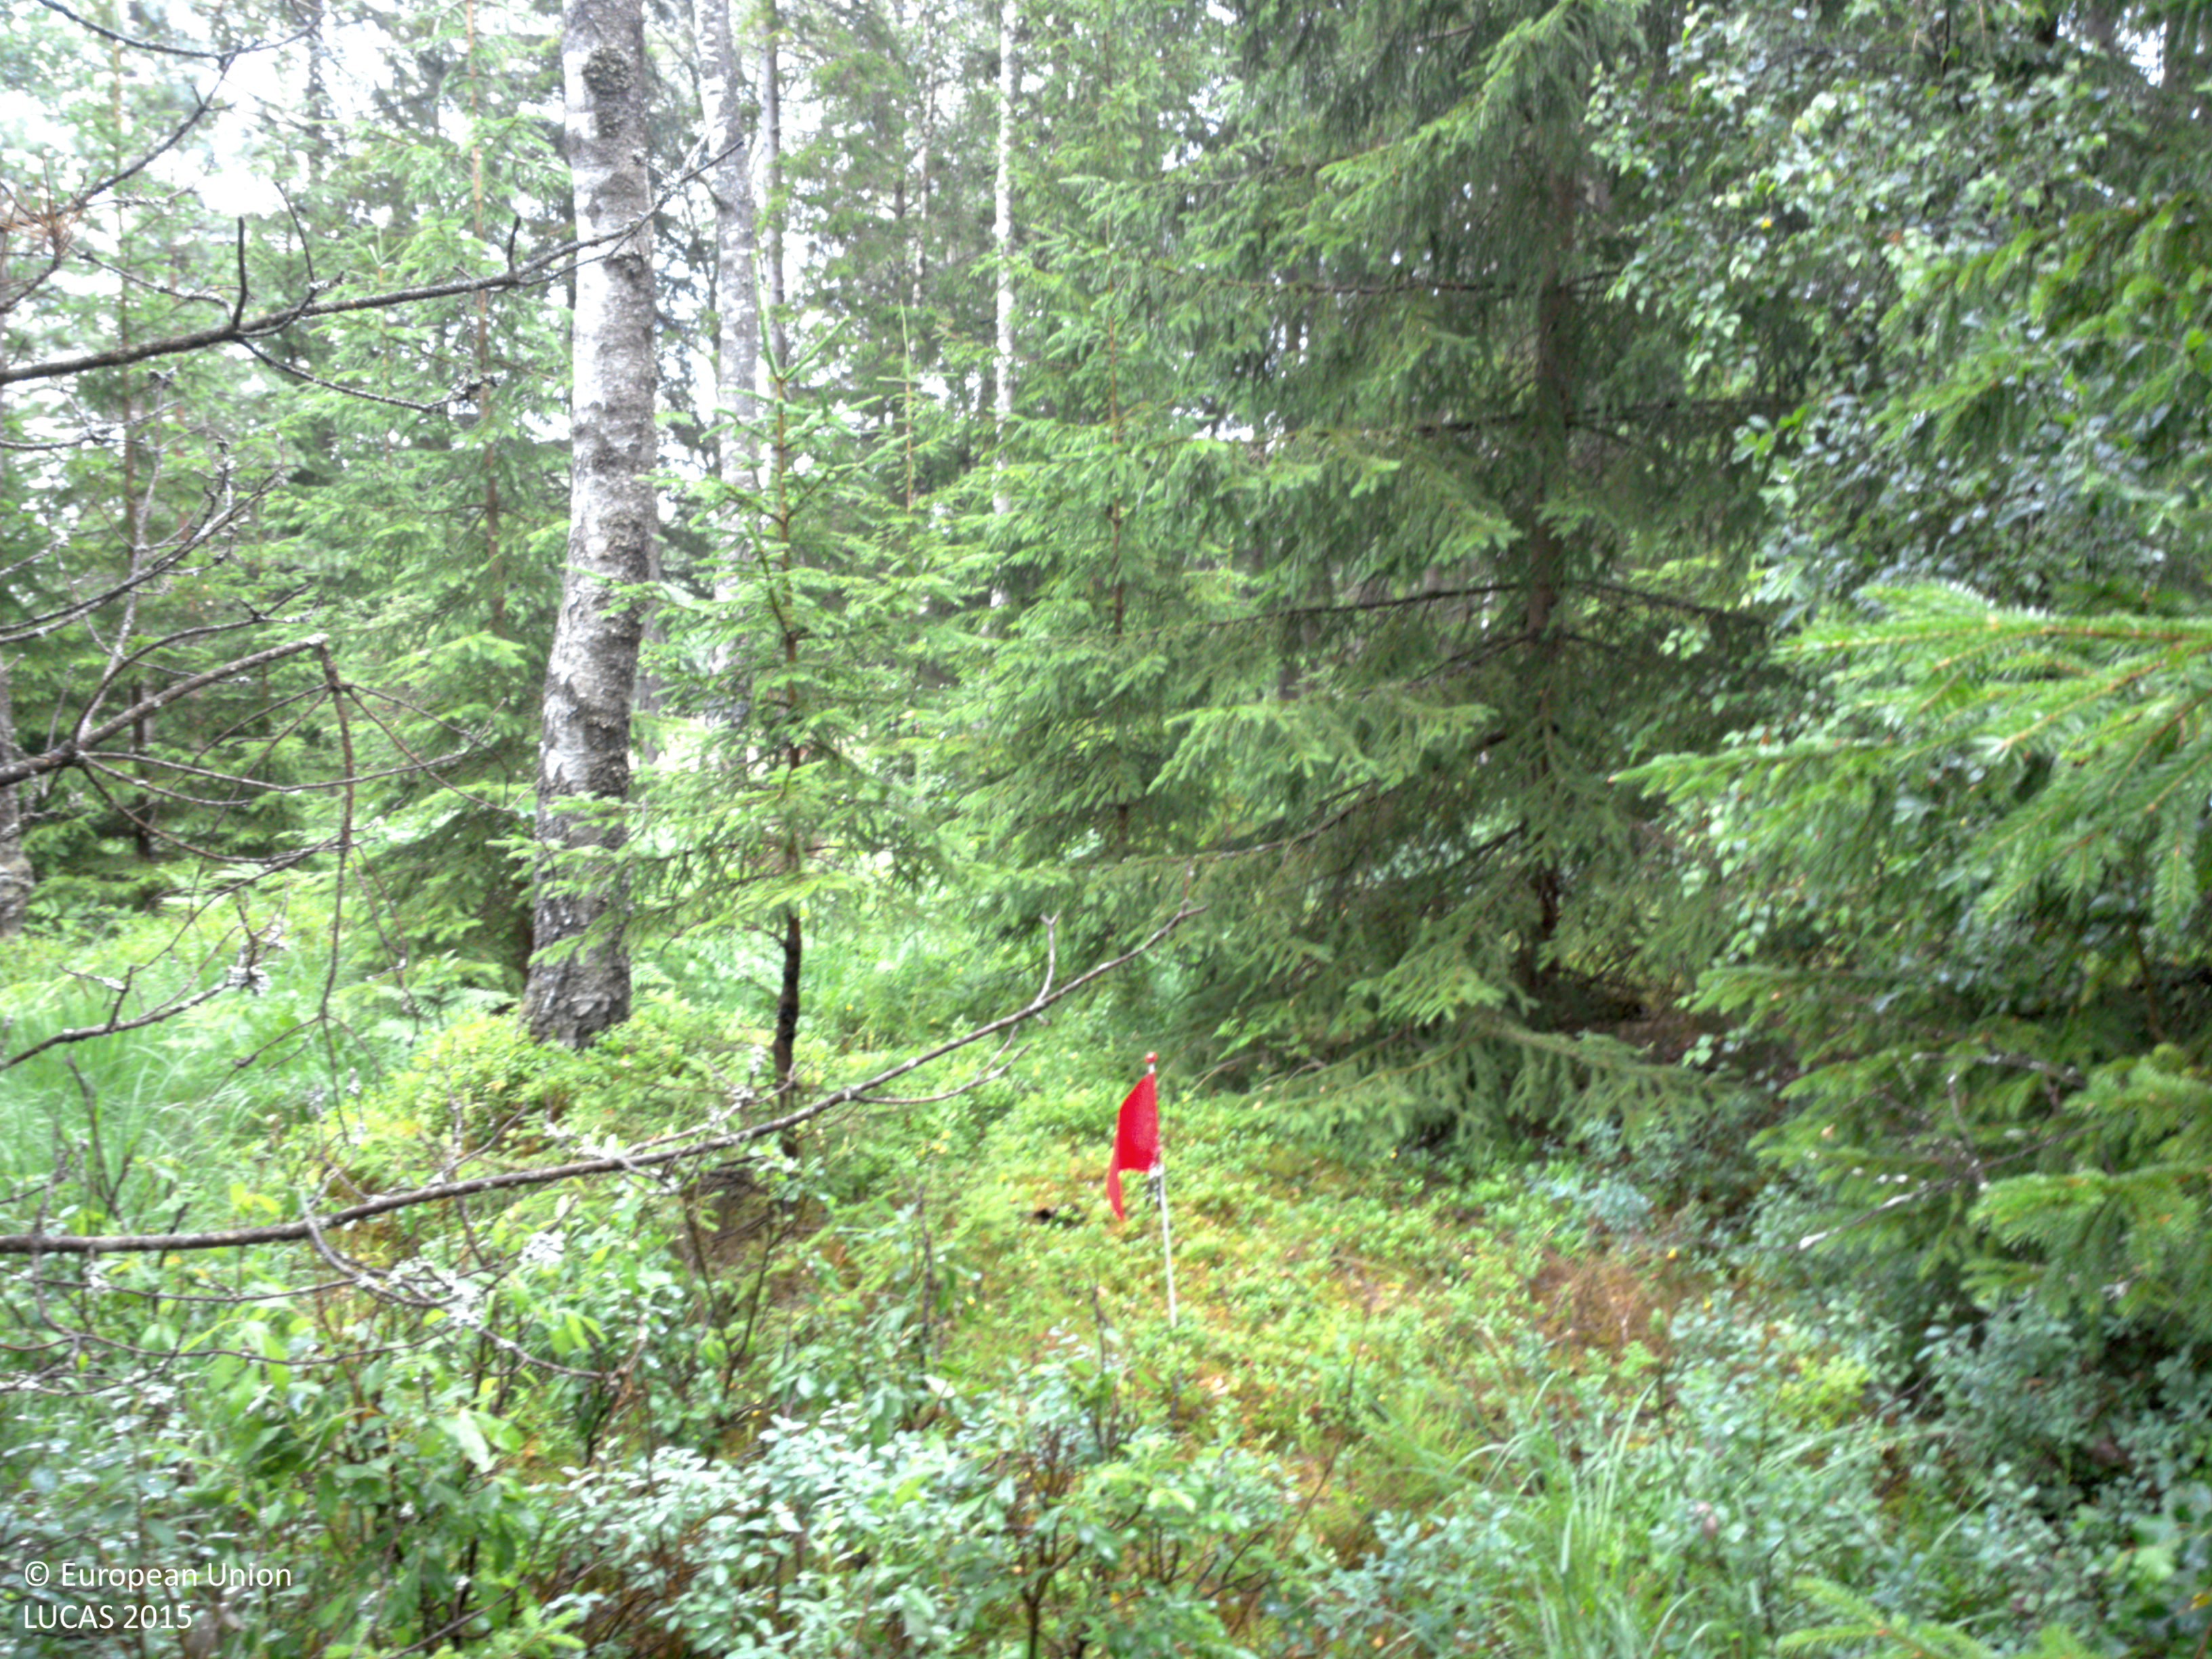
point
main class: Woodland
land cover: Spruce dominated mixed woodland
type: boreal forest
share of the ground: > 75 %
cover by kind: coniferous forest trees 60 %, broadleaved forest trees 25 %, herbaceous plants 15 %
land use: Forestry
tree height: > 5 m
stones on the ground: < 10 %
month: July
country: SE
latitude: 58.6413
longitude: 11.6331
